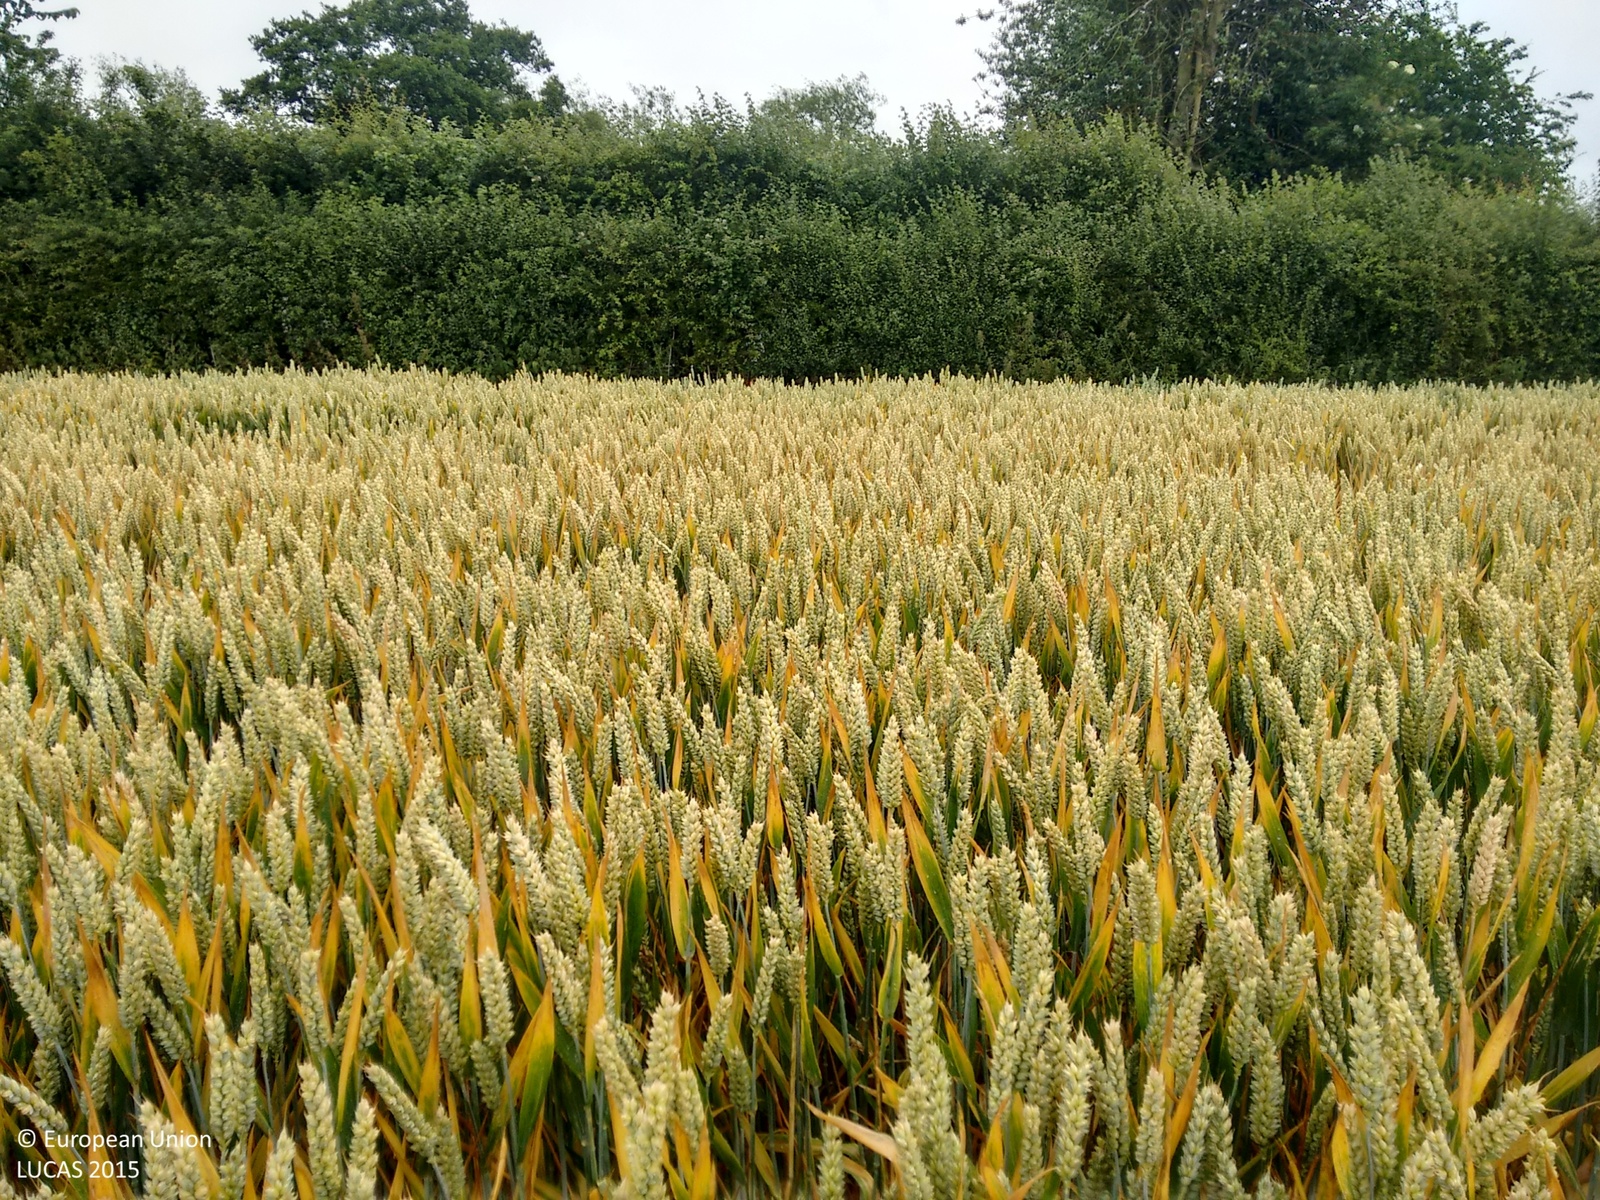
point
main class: Cropland
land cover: Common wheat
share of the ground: > 75 %
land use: Agriculture (excluding fallow land and kitchen gardens)
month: July
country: GB
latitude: 52.2601
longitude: -2.8331
